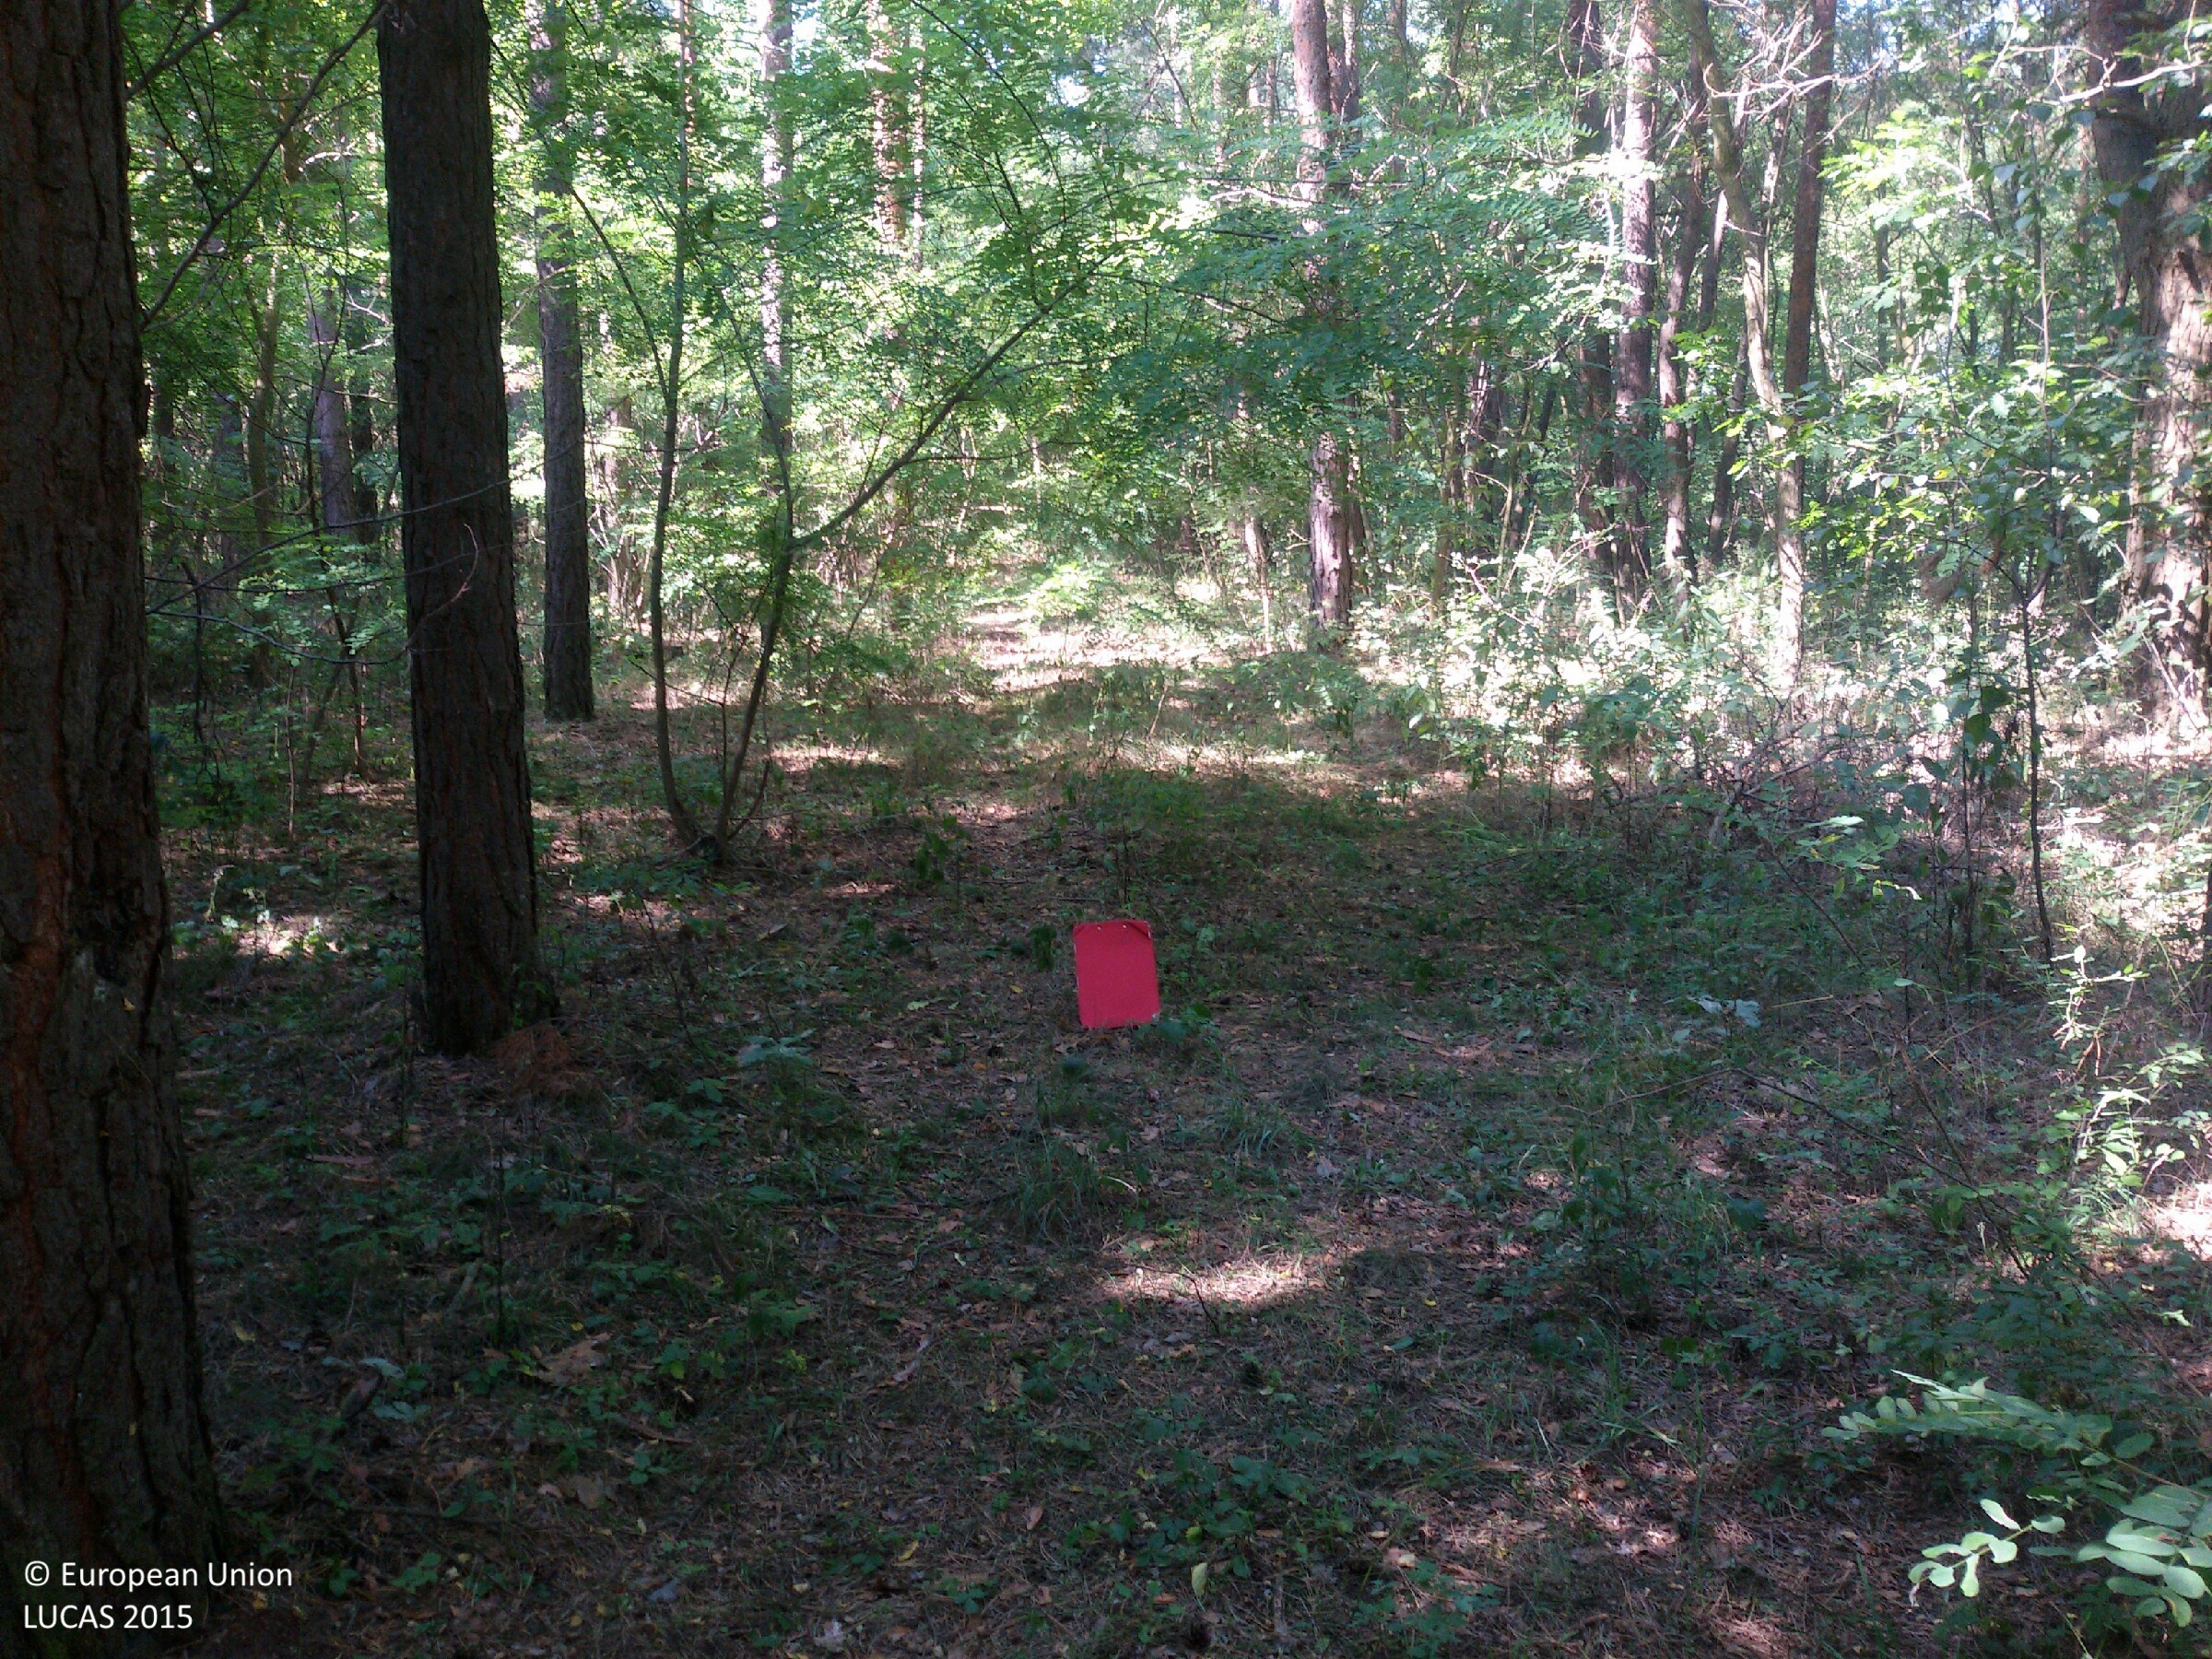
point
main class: Woodland
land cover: Pine dominated mixed woodland
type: hemiboreal forest and nemoral coniferous forest and mixed broadleaved-coniferous forest
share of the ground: > 75 %
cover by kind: coniferous forest trees 65 %, broadleaved forest trees 25 %, shrubs 5 %, herbaceous plants 5 %
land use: Forestry
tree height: > 5 m
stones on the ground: < 10 %
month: August
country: PL
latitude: 51.2826
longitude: 21.0126
